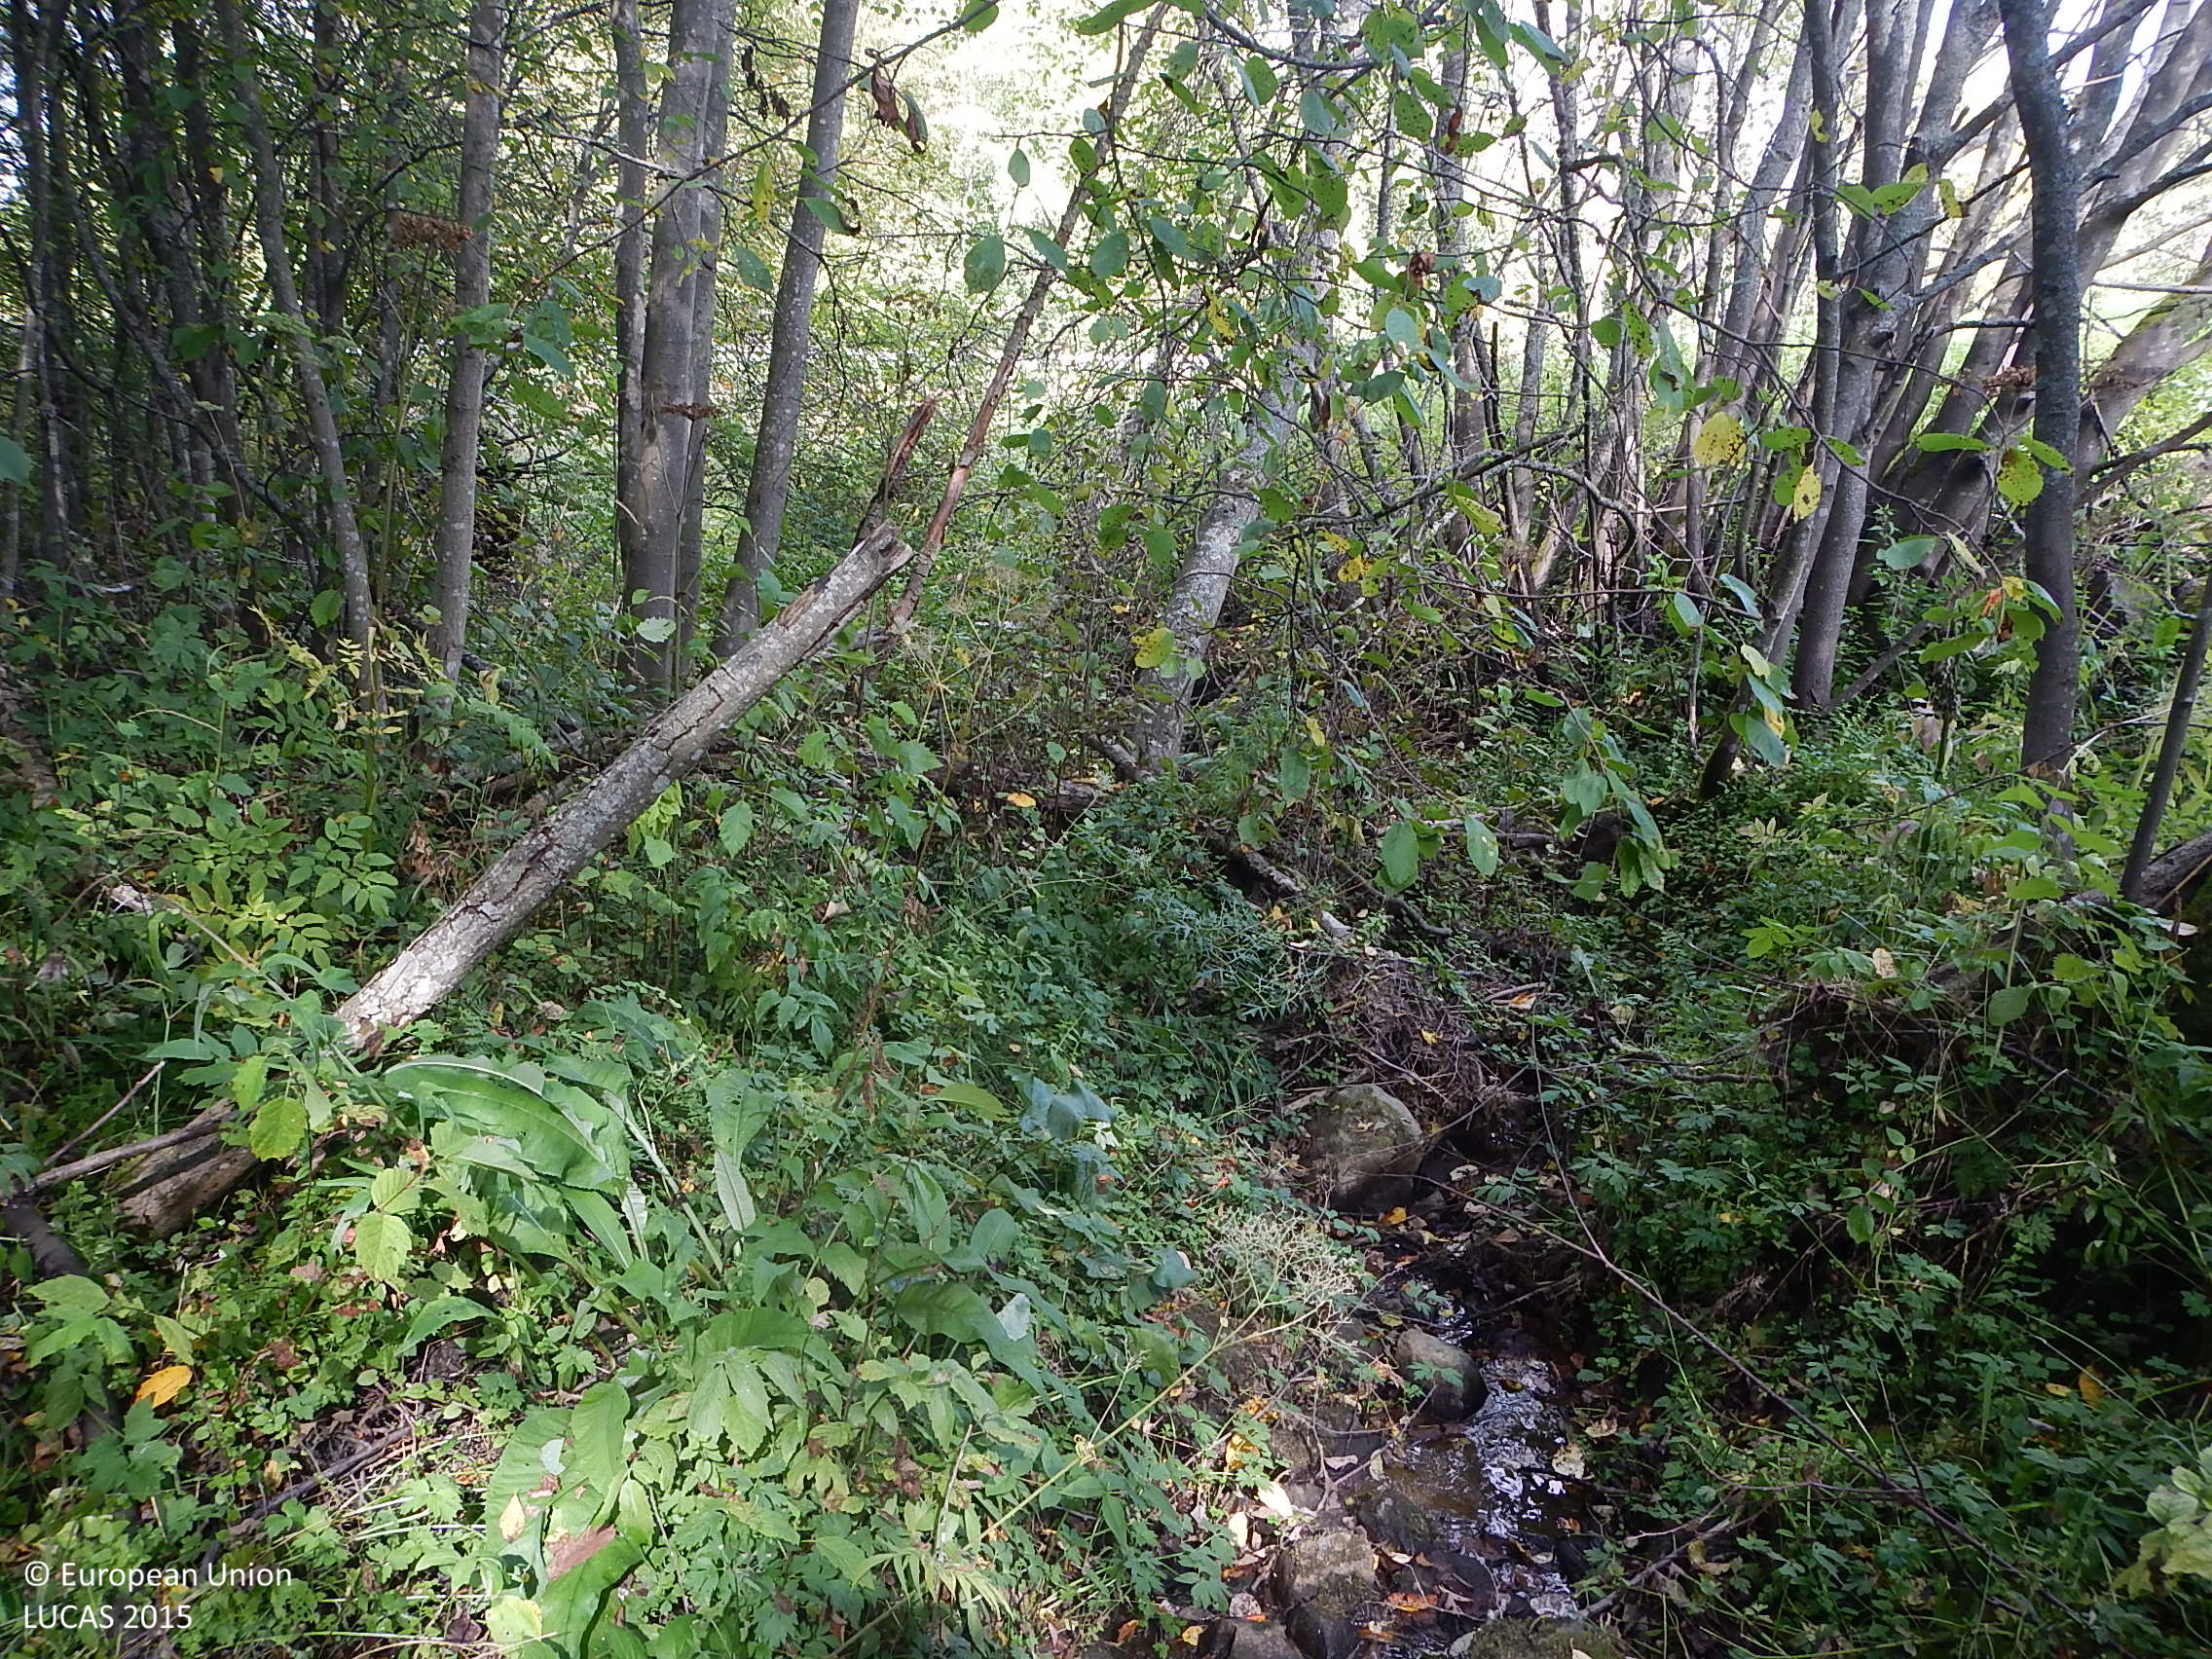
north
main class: Woodland
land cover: Broadleaved woodland
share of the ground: > 75 %
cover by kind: broadleaved forest trees 90 %, shrubs 10 %
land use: Semi-natural and natural areas not in use
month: September
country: FI
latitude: 61.4541
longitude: 22.0065
